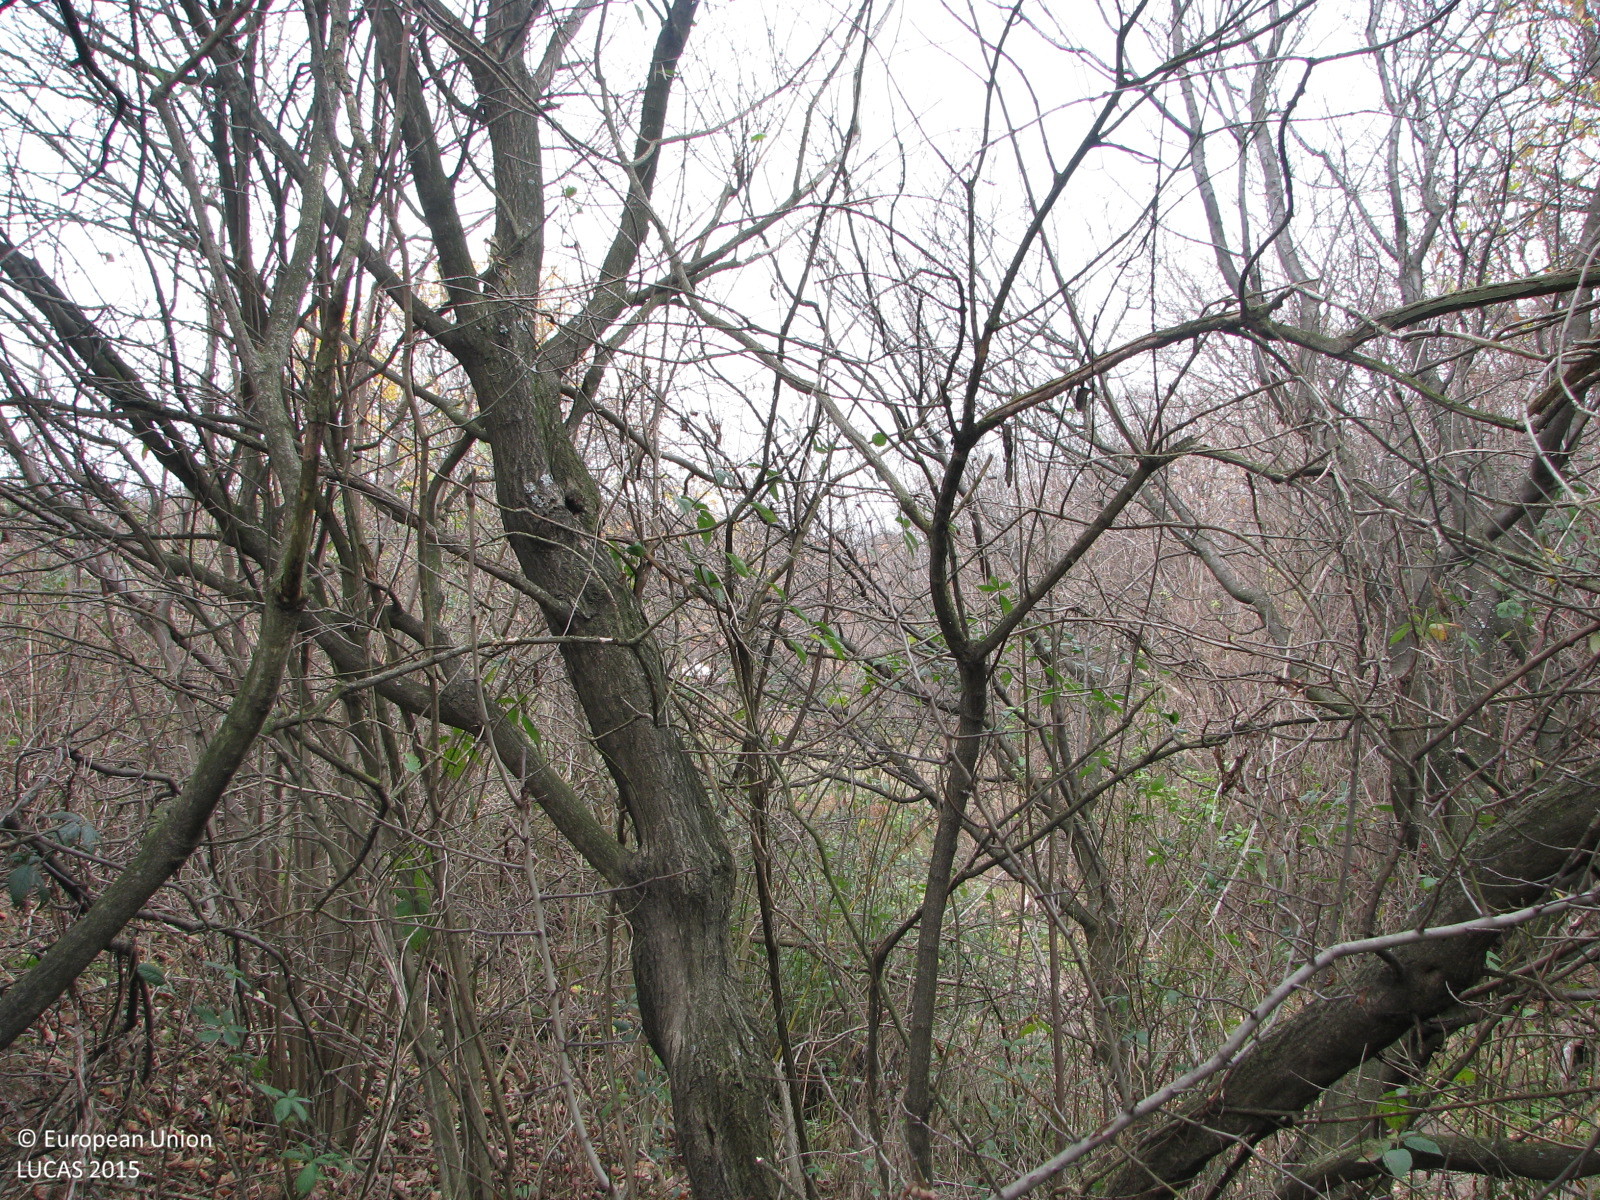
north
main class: Woodland
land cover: Broadleaved woodland
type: mesophytic deciduous forest
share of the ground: > 75 %
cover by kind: broadleaved forest trees 80 %, herbaceous plants 10 %, unconsolidated bare surface 10 %
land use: Semi-natural and natural areas not in use
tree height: < 5 m
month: December
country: BG
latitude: 42.5470
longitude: 24.1844
